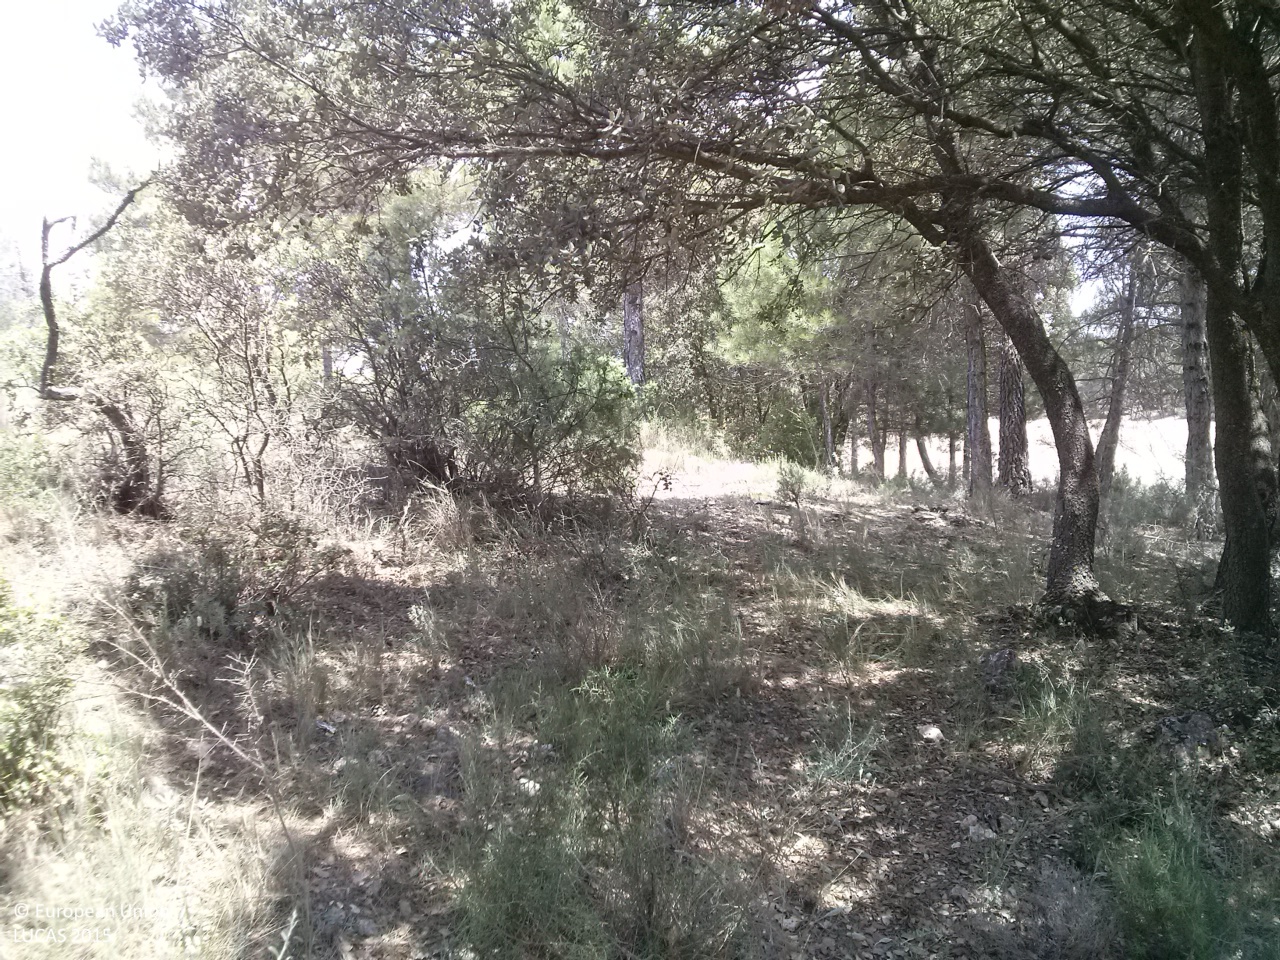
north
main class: Woodland
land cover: Other mixed woodland
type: broadleaved evergreen forest
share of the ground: 25 - 50 %
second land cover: Shrubland without tree cover
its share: 25 - 50 %
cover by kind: shrubs 30 %, coniferous forest trees 25 %, herbaceous plants 20 %, broadleaved forest trees 15 %, unconsolidated bare surface 10 %
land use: Forestry
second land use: Agriculture (excluding fallow land and kitchen gardens)
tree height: > 5 m
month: June
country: ES
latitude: 39.8803
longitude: -1.8089
